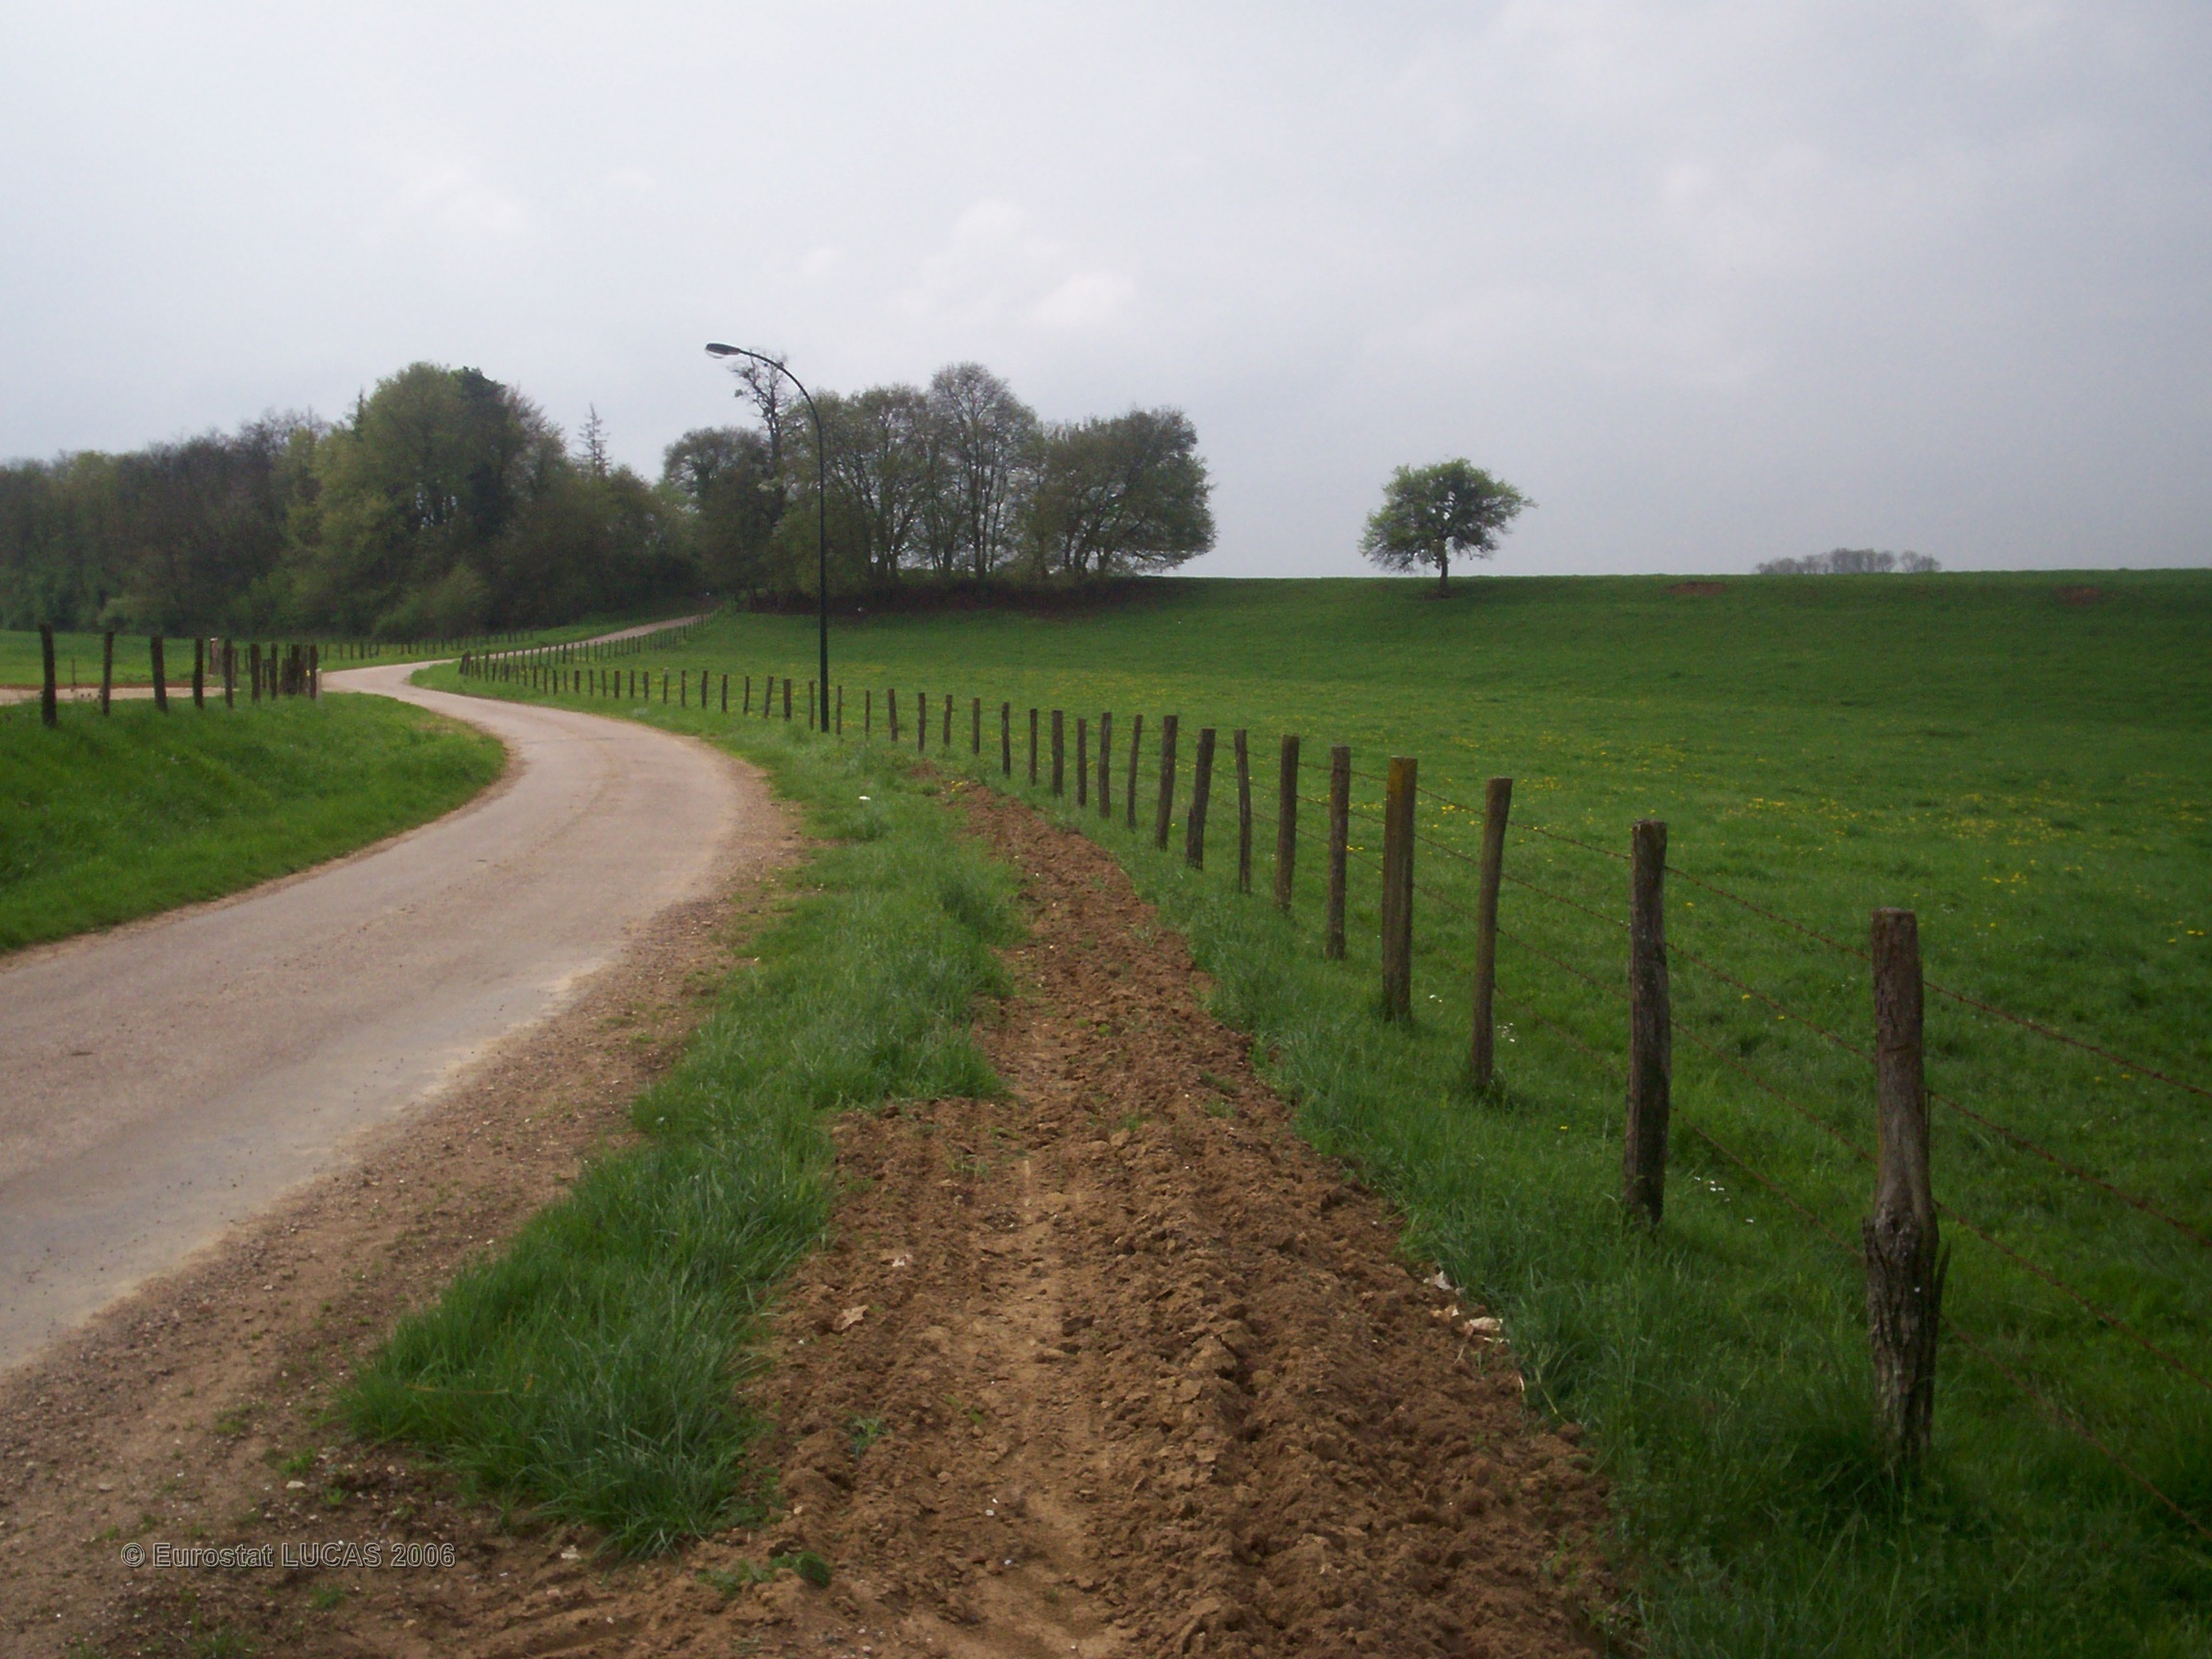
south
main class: Grassland
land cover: Grassland without tree/shrub cover
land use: Agriculture (excluding fallow land and kitchen gardens)
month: April
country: FR
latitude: 47.6103
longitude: 5.9969
